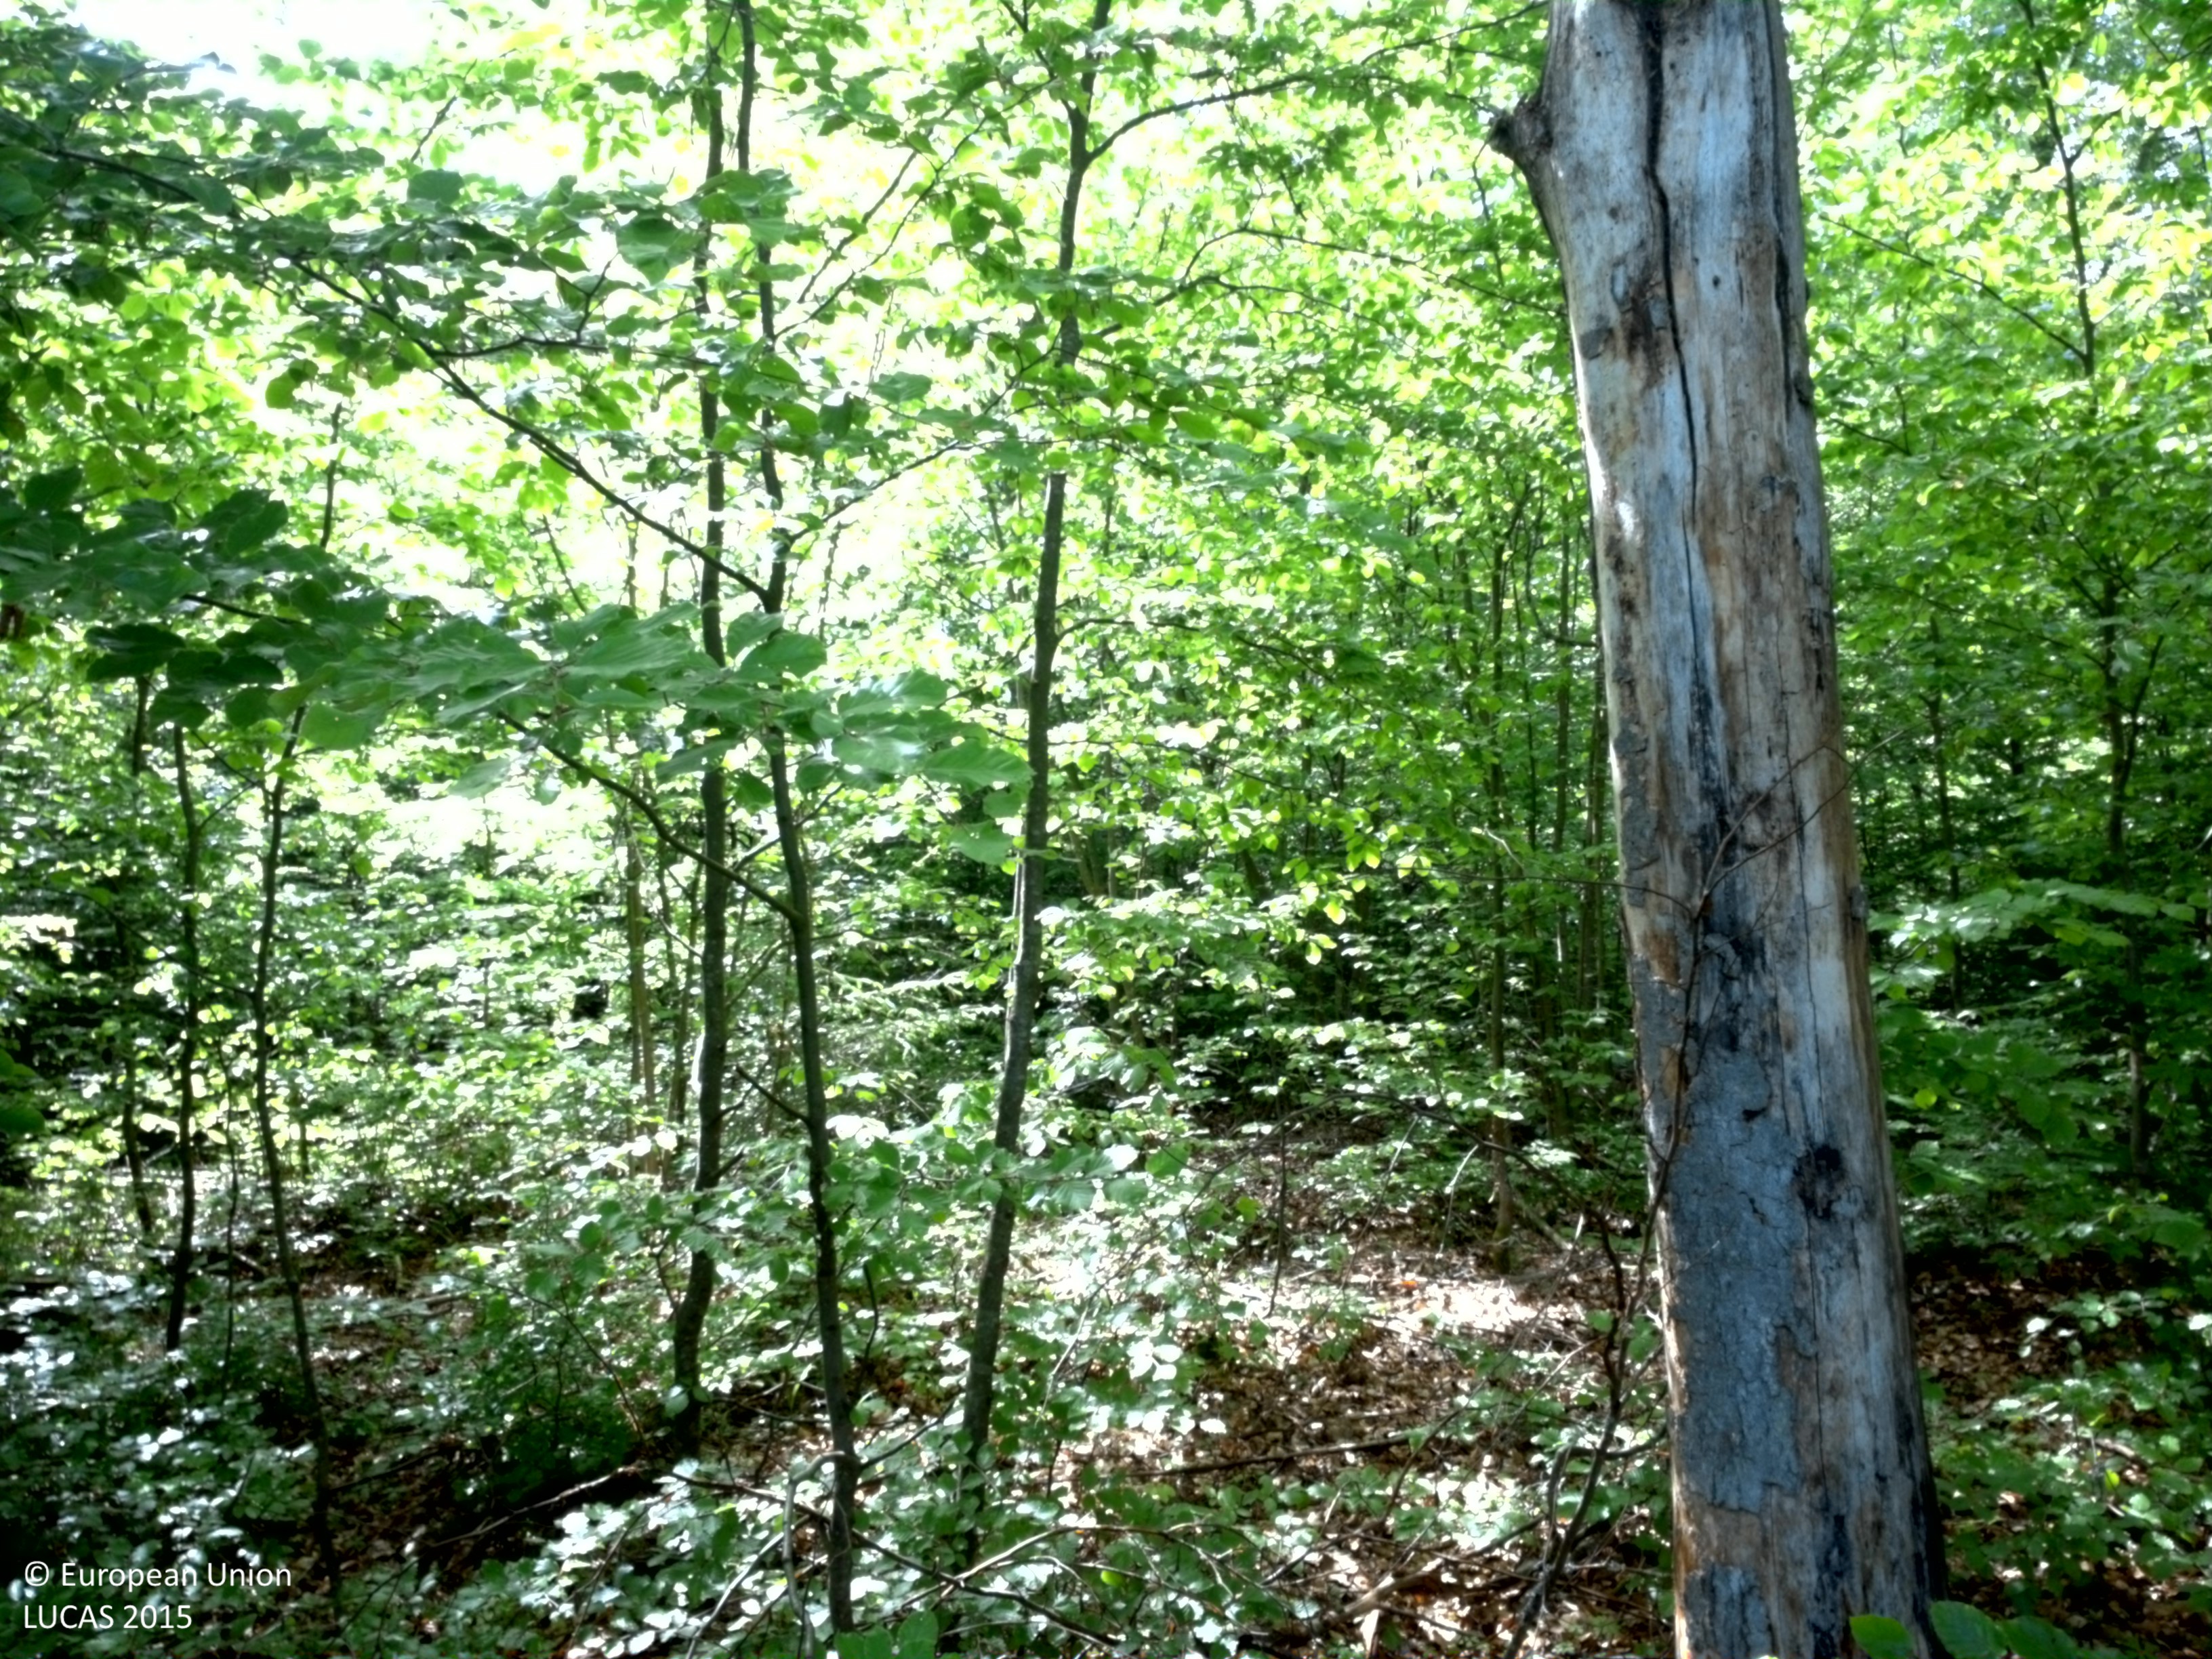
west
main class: Woodland
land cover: Broadleaved woodland
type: beech forest
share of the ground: > 75 %
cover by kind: broadleaved forest trees 65 %, coniferous forest trees 10 %, shrubs 10 %, herbaceous plants 10 %, lichens and mosses 5 %
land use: Forestry
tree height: > 5 m
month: June
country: SE
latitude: 56.7481
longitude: 14.7559
